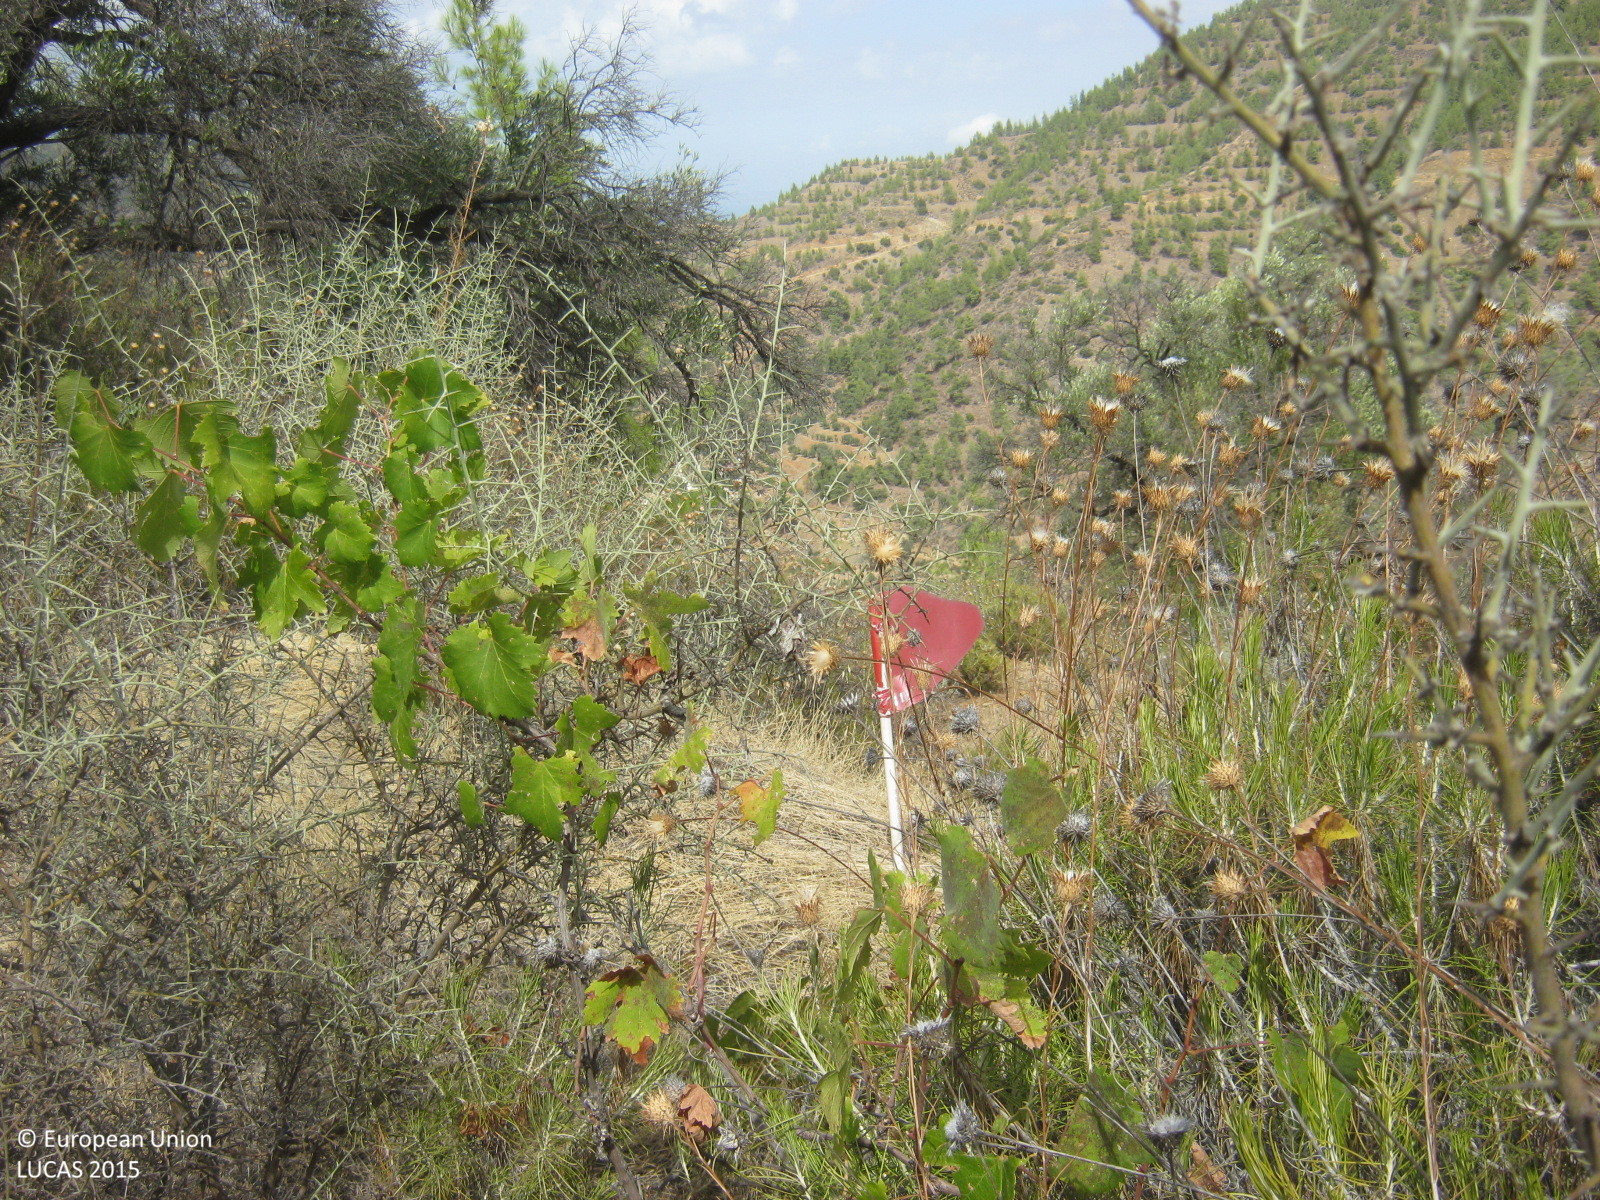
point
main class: Woodland
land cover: Other mixed woodland
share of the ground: 25 - 50 %
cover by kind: shrubs 30 %, herbaceous plants 30 %, broadleaved forest trees 25 %, coniferous forest trees 15 %
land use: Semi-natural and natural areas not in use
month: September
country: CY
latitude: 35.0265
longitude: 32.8228
